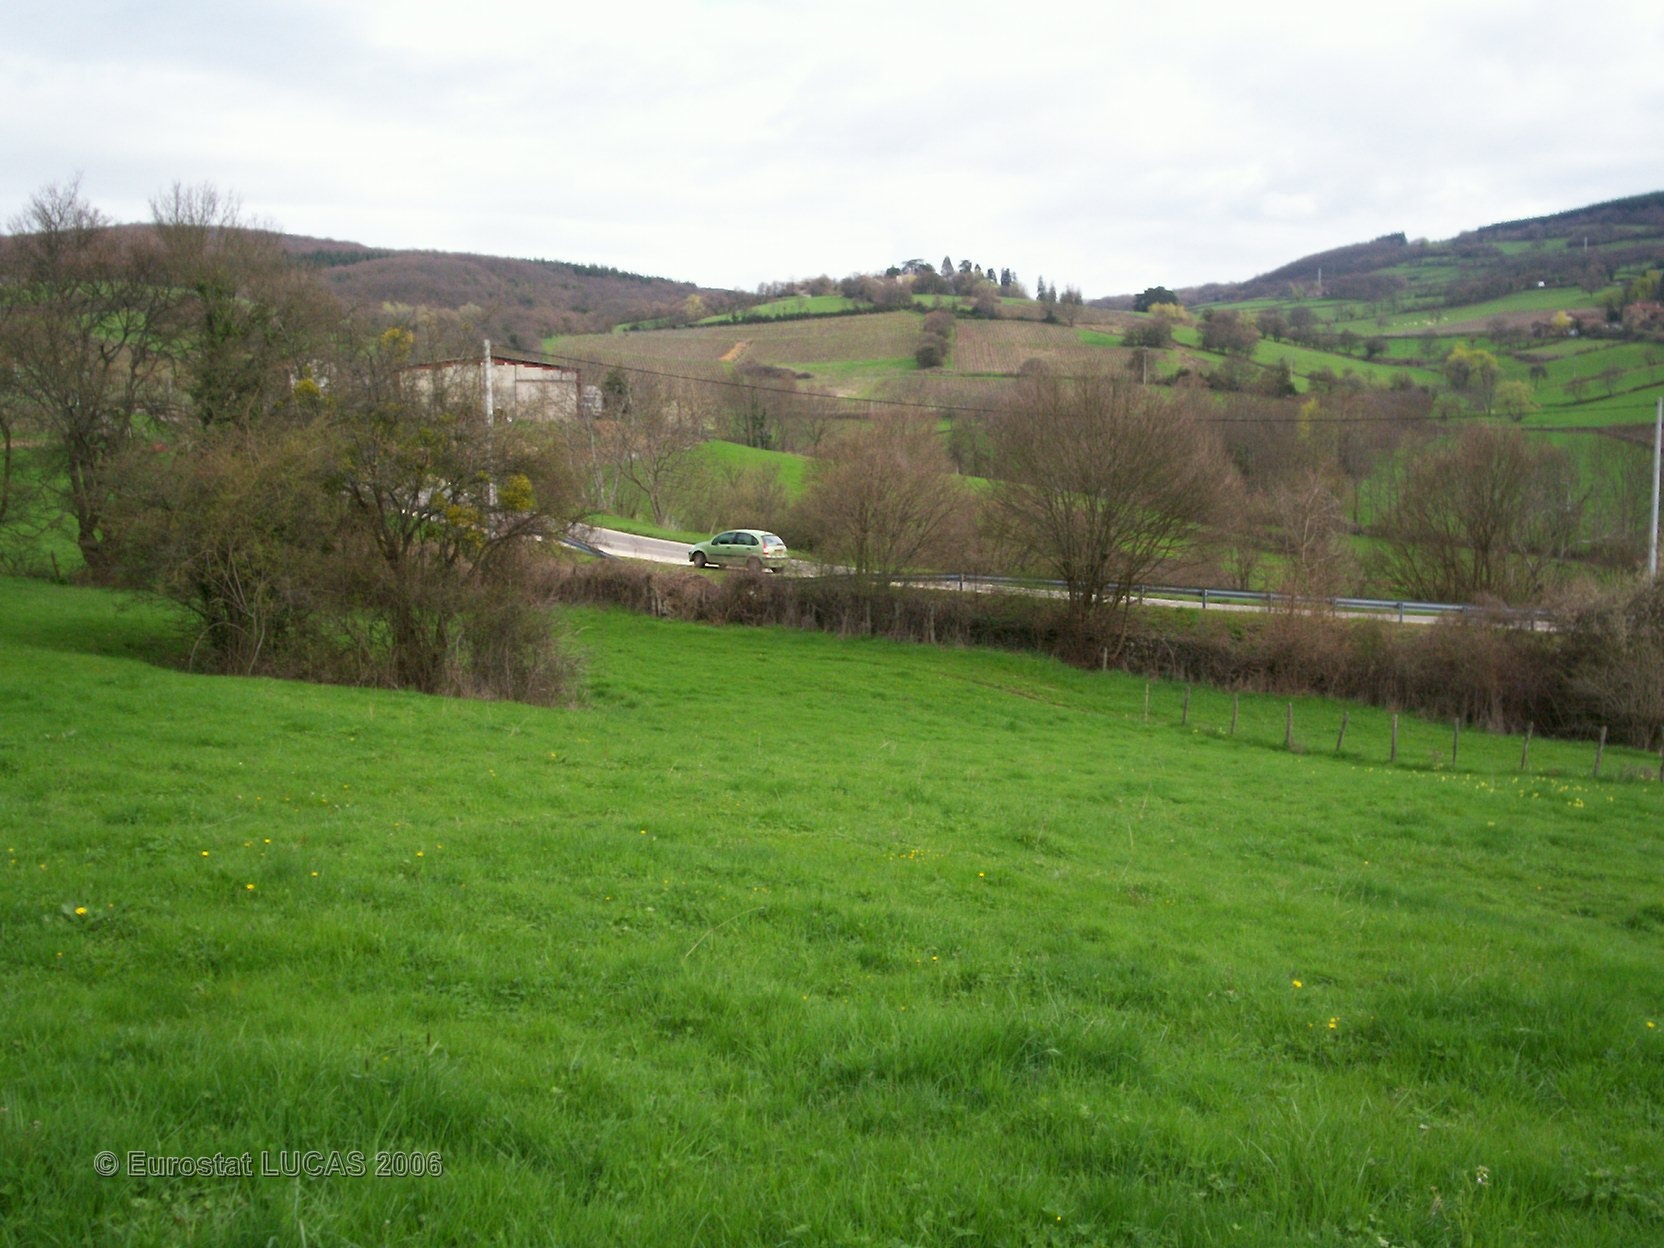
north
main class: Grassland
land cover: Grassland without tree/shrub cover
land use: Agriculture (excluding fallow land and kitchen gardens)
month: April
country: FR
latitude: 46.3815
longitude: 4.6841
